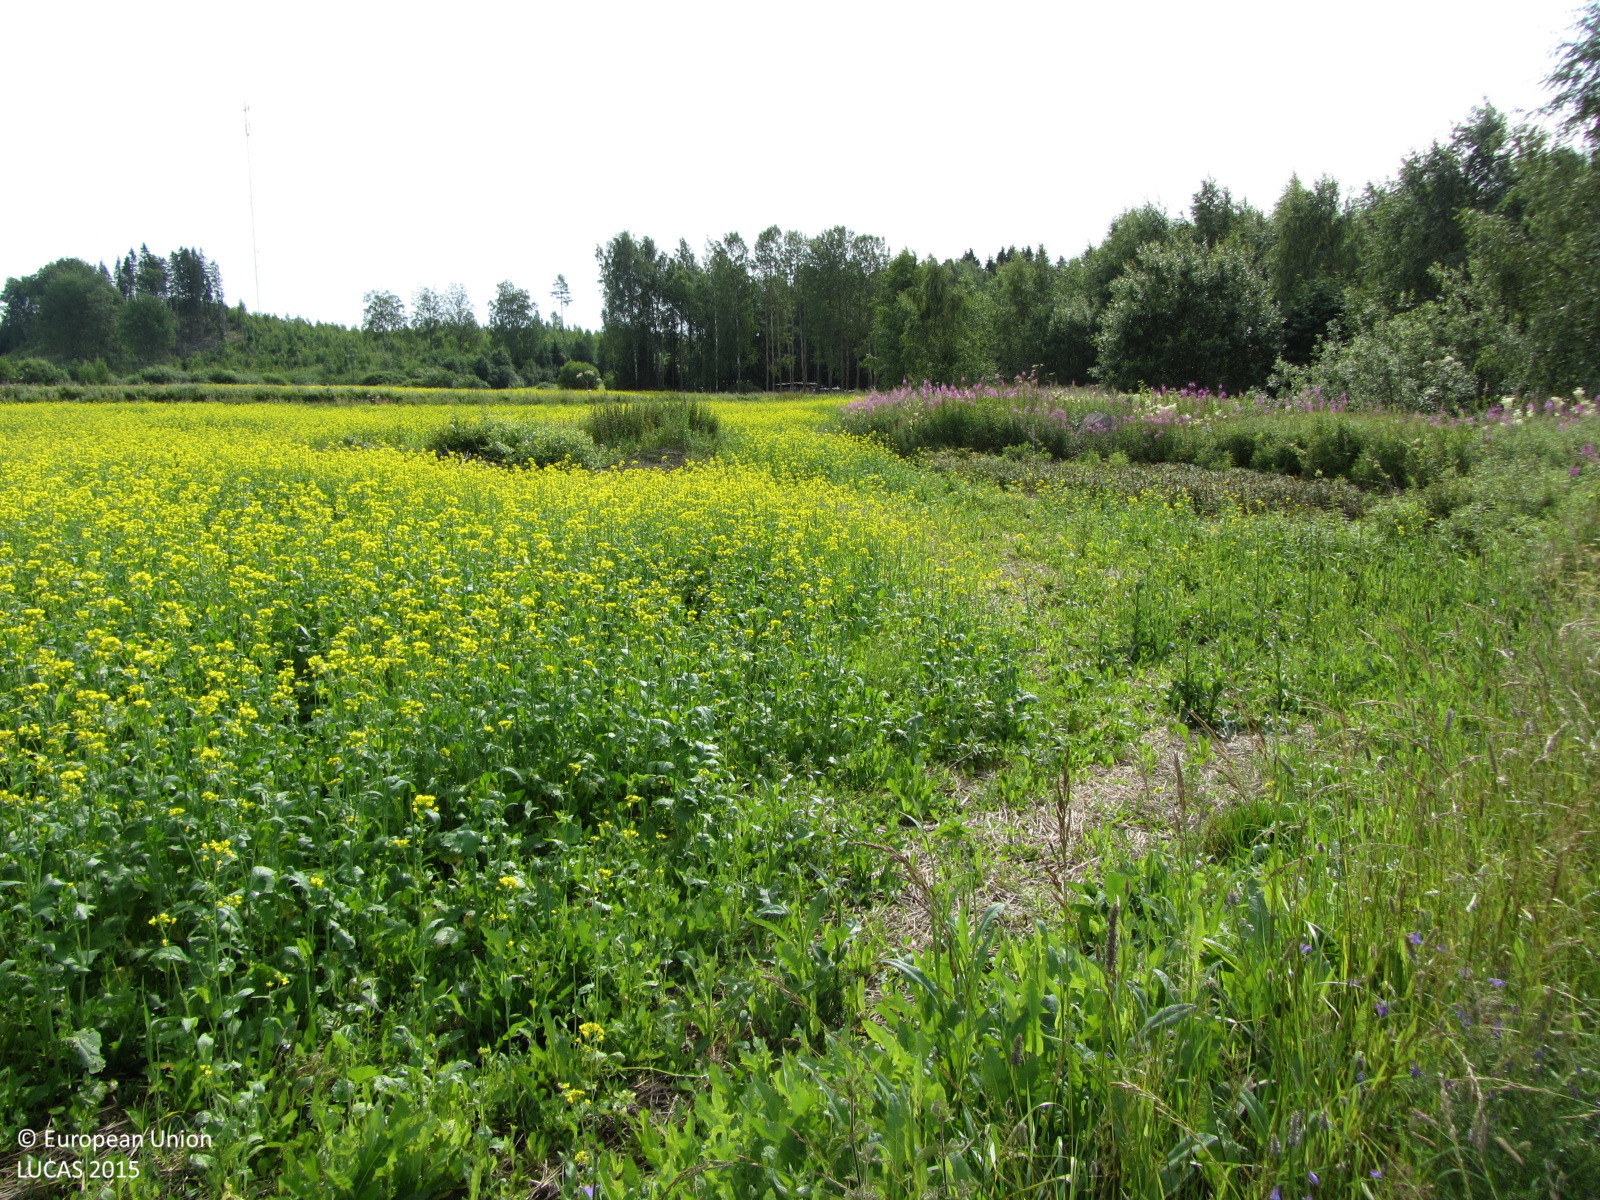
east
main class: Grassland
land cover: Spontaneously vegetated surfaces
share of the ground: > 75 %
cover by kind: herbaceous plants 100 %
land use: Fallow land
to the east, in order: Spontaneously vegetated surfaces; Fences; Rape and turnip rape
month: July
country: FI
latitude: 60.5784
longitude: 24.3557
